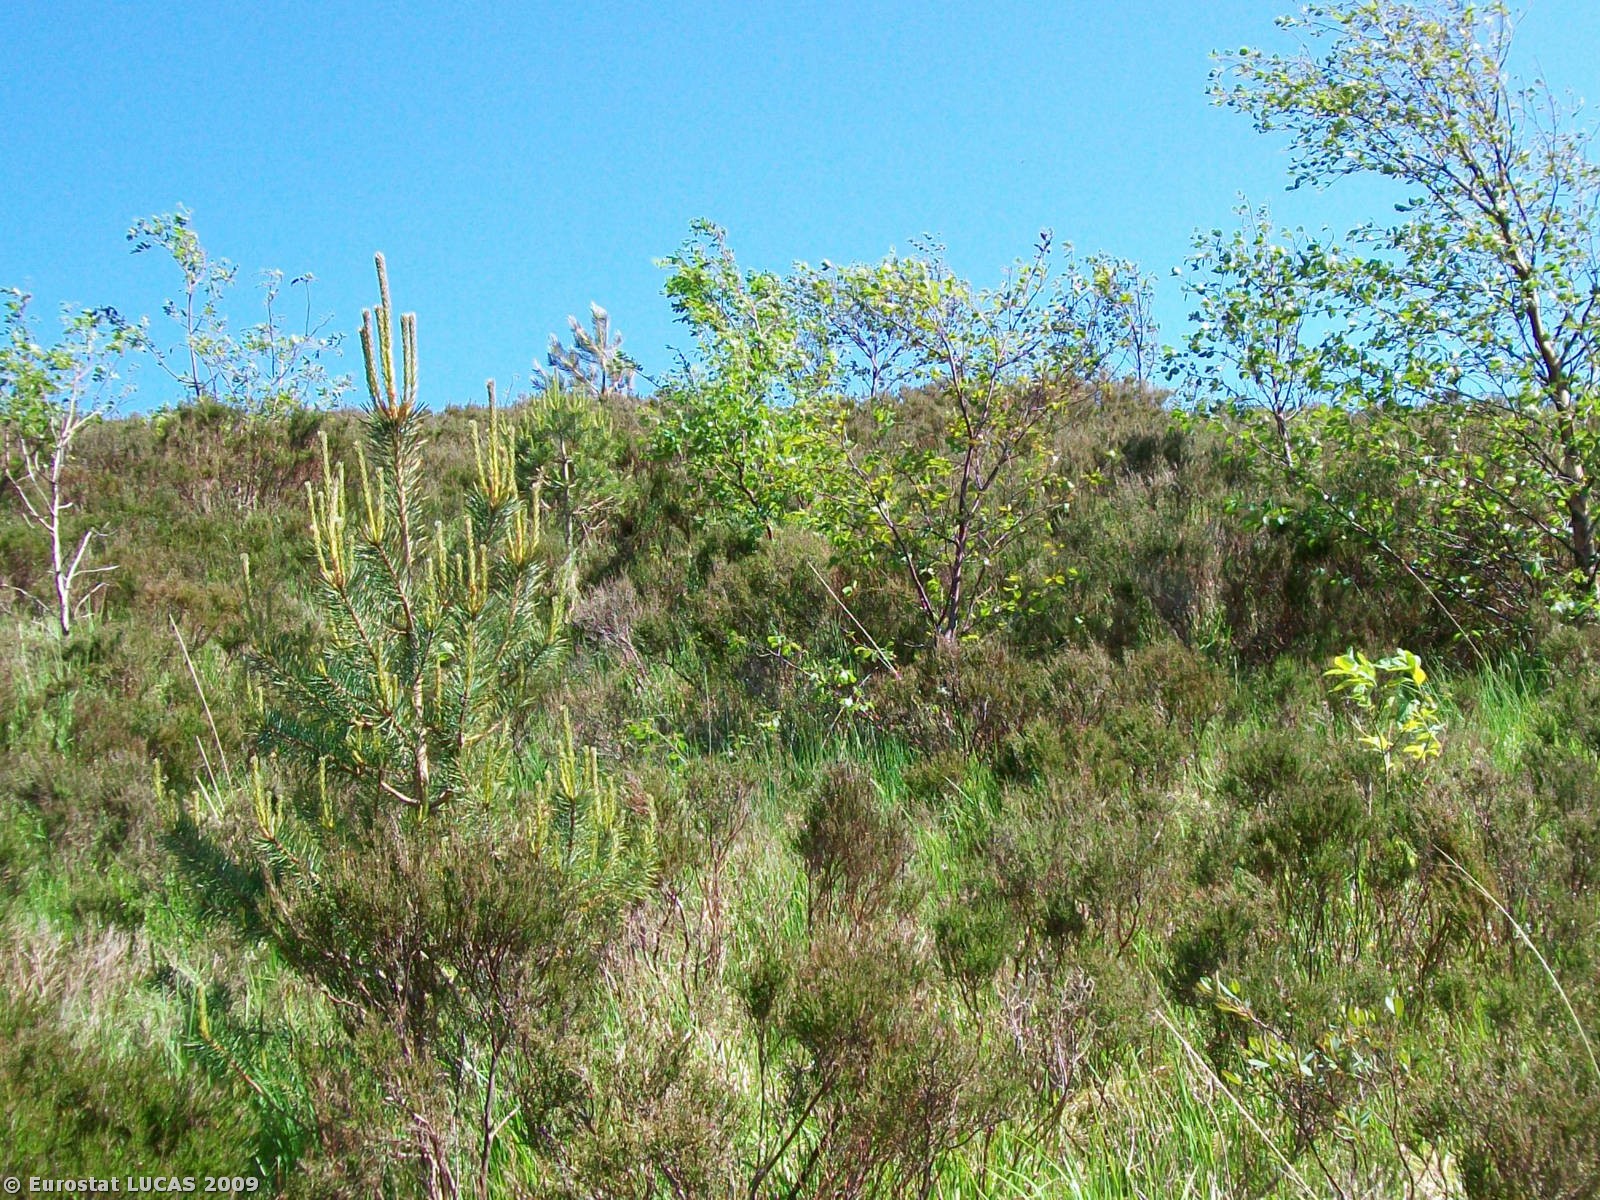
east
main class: Shrubland
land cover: Shrubland with sparse tree cover
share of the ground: > 75 %
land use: Forestry
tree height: > 5 m
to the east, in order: Shrubland with sparse tree cover; Shrubland without tree cover
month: May
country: GB
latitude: 56.6623
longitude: -5.4042
